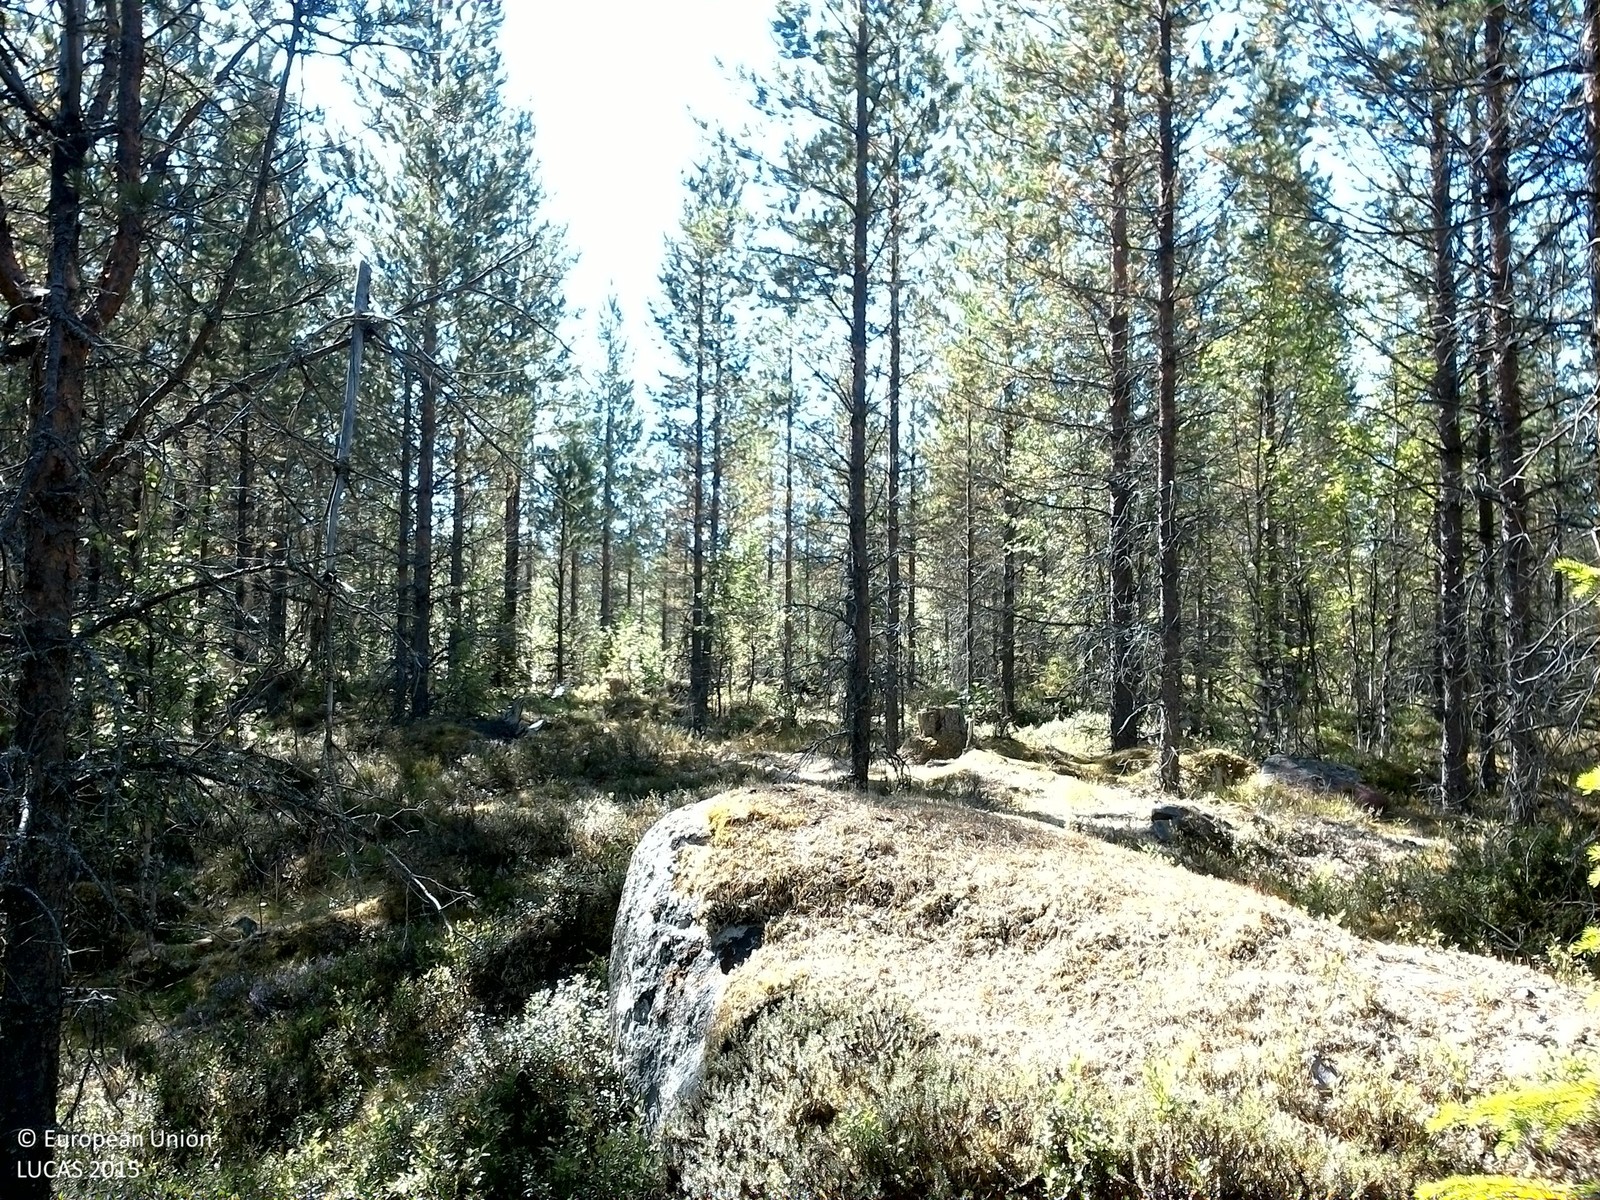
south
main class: Woodland
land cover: Pine dominated coniferous woodland
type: boreal forest
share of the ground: > 75 %
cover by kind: coniferous forest trees 75 %, shrubs 15 %, herbaceous plants 5 %, lichens and mosses 5 %
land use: Forestry
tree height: < 5 m
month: August
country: SE
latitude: 63.7249
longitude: 17.2411
